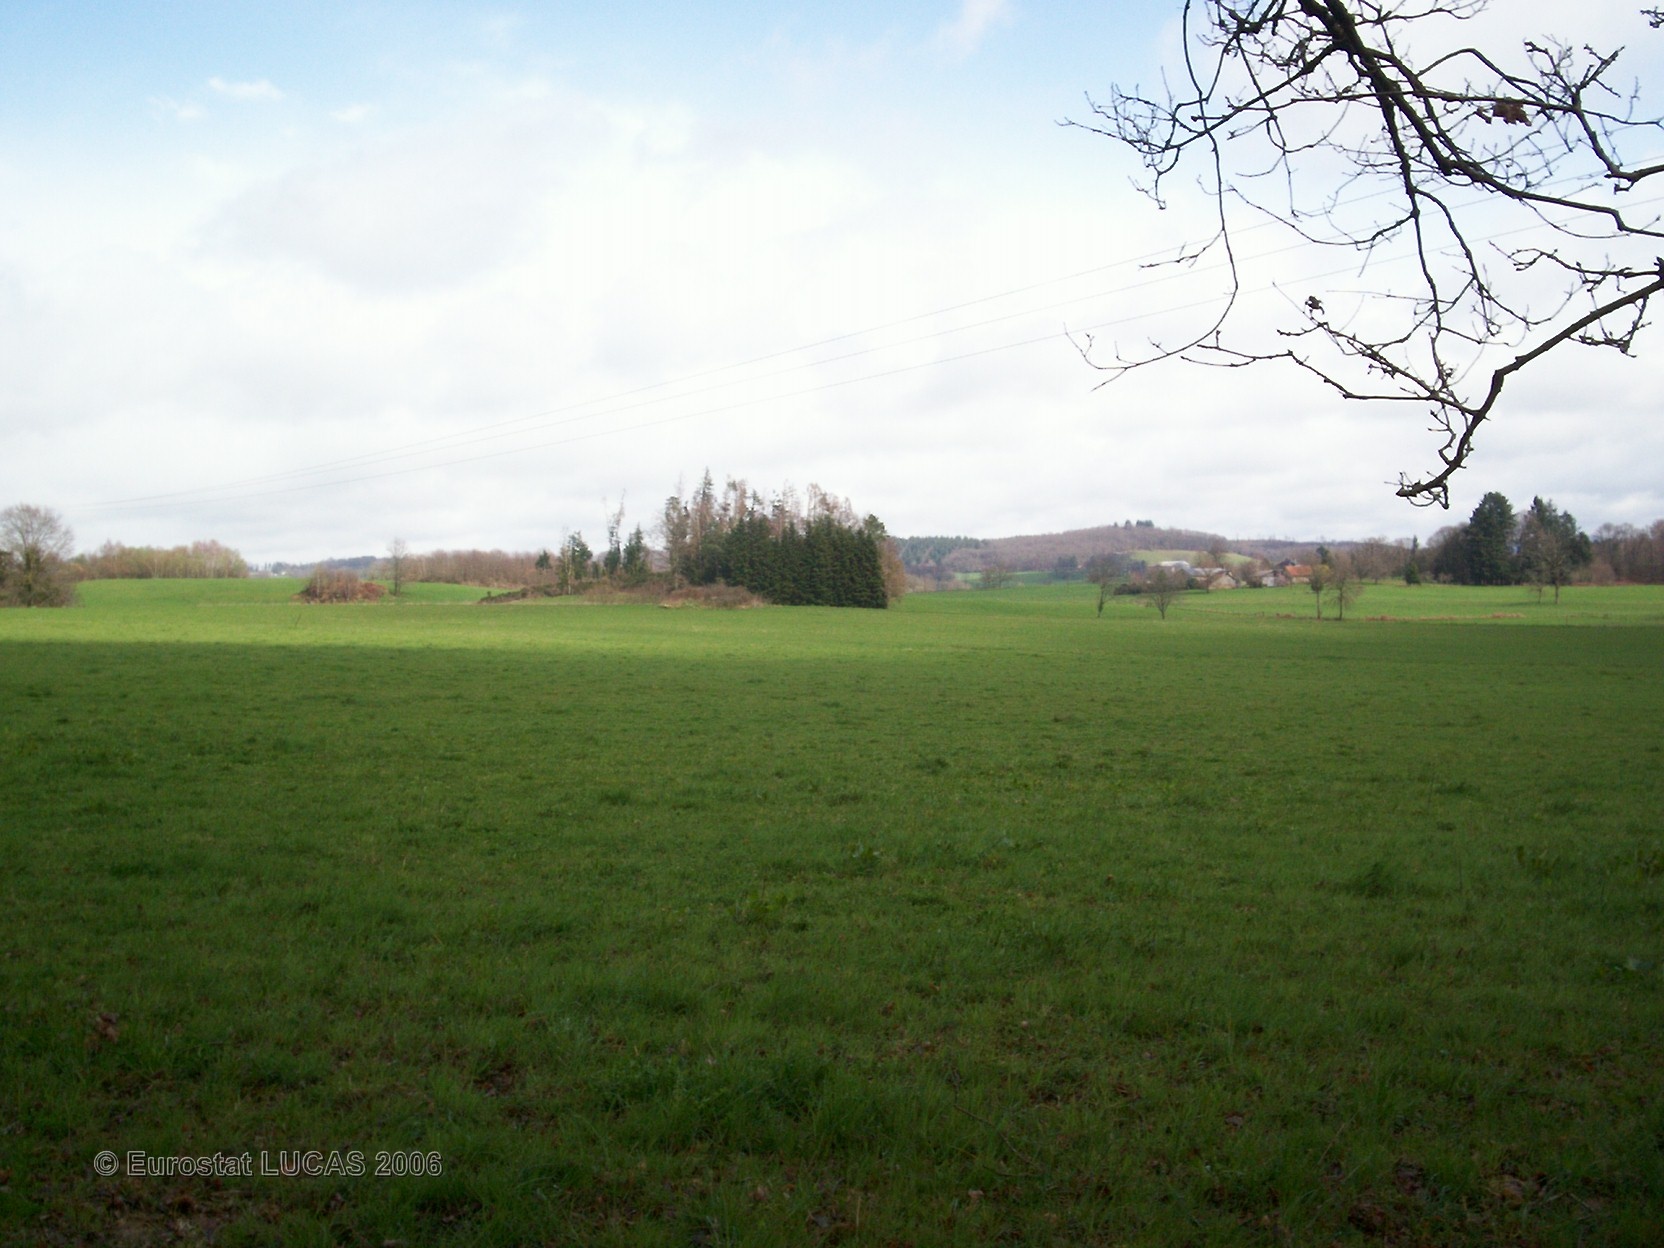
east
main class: Woodland
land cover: Broadleaved forest
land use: Forestry
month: April
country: FR
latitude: 45.5499
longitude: 1.6041
